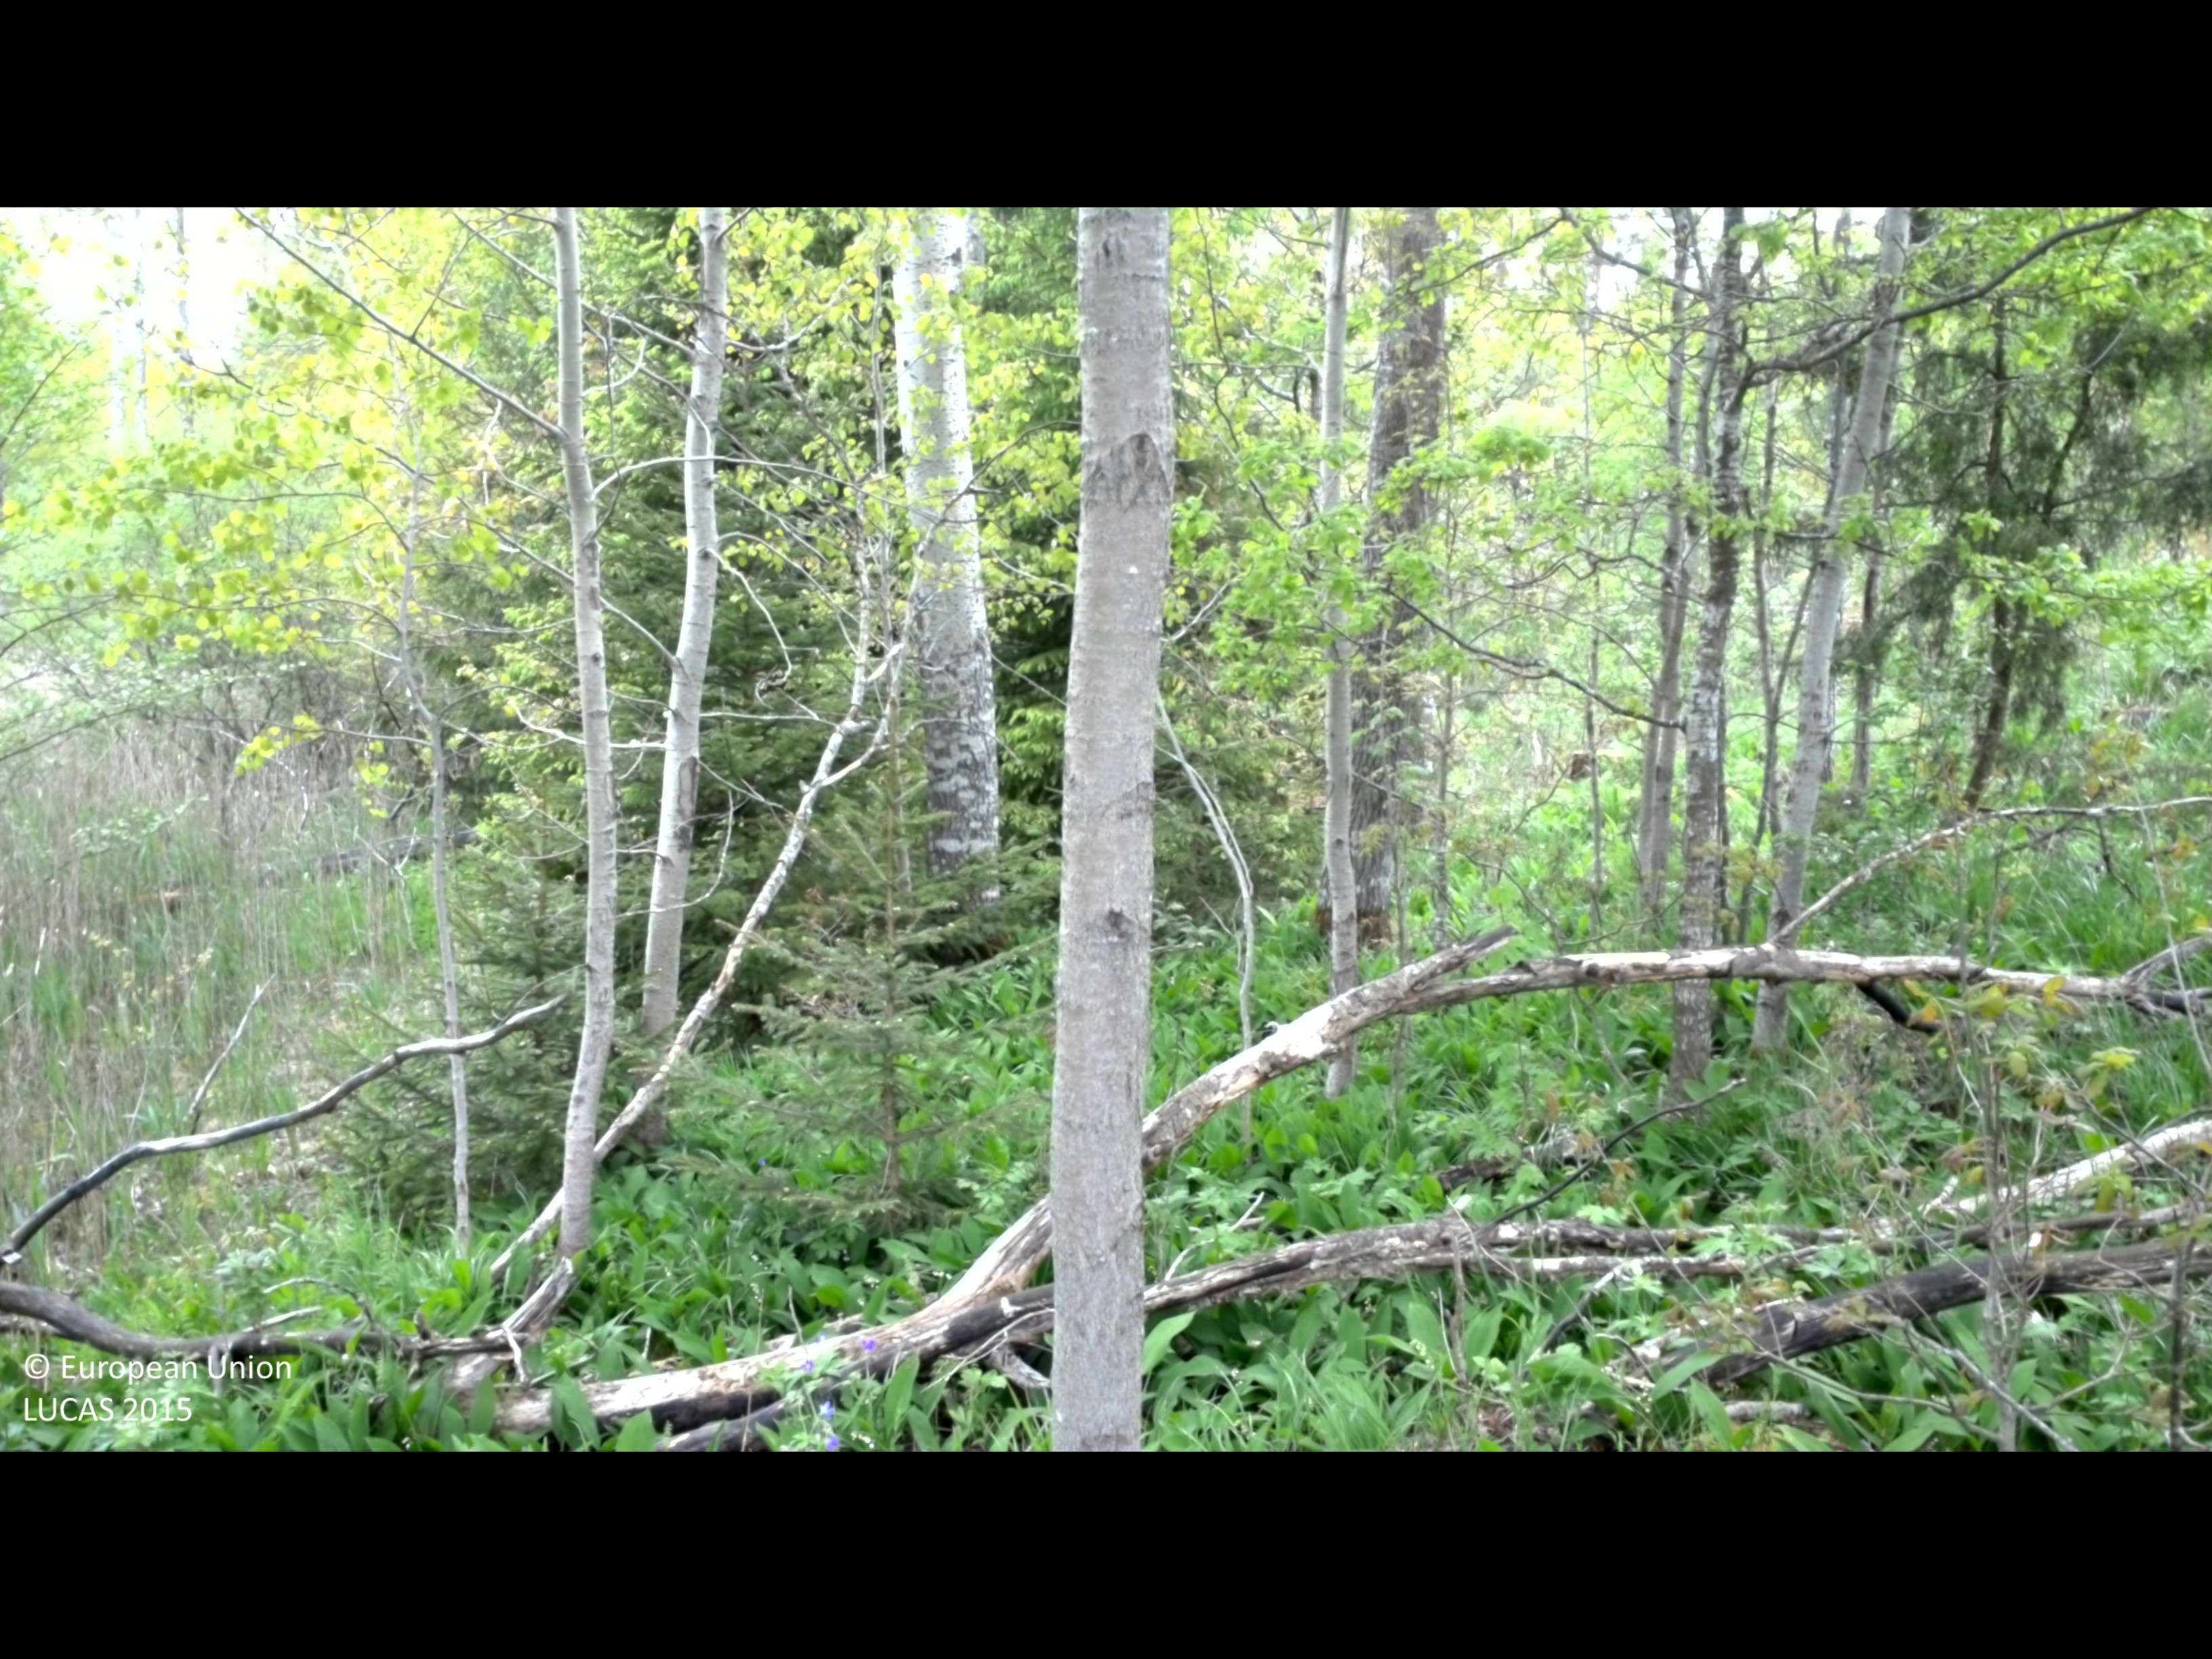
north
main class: Woodland
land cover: Broadleaved woodland
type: hemiboreal forest and nemoral coniferous forest and mixed broadleaved-coniferous forest
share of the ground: 50 - 75 %
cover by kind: broadleaved forest trees 50 %, herbaceous plants 25 %, shrubs 15 %, coniferous forest trees 5 %
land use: Forestry
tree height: > 5 m
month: June
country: SE
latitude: 57.6801
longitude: 16.1859
